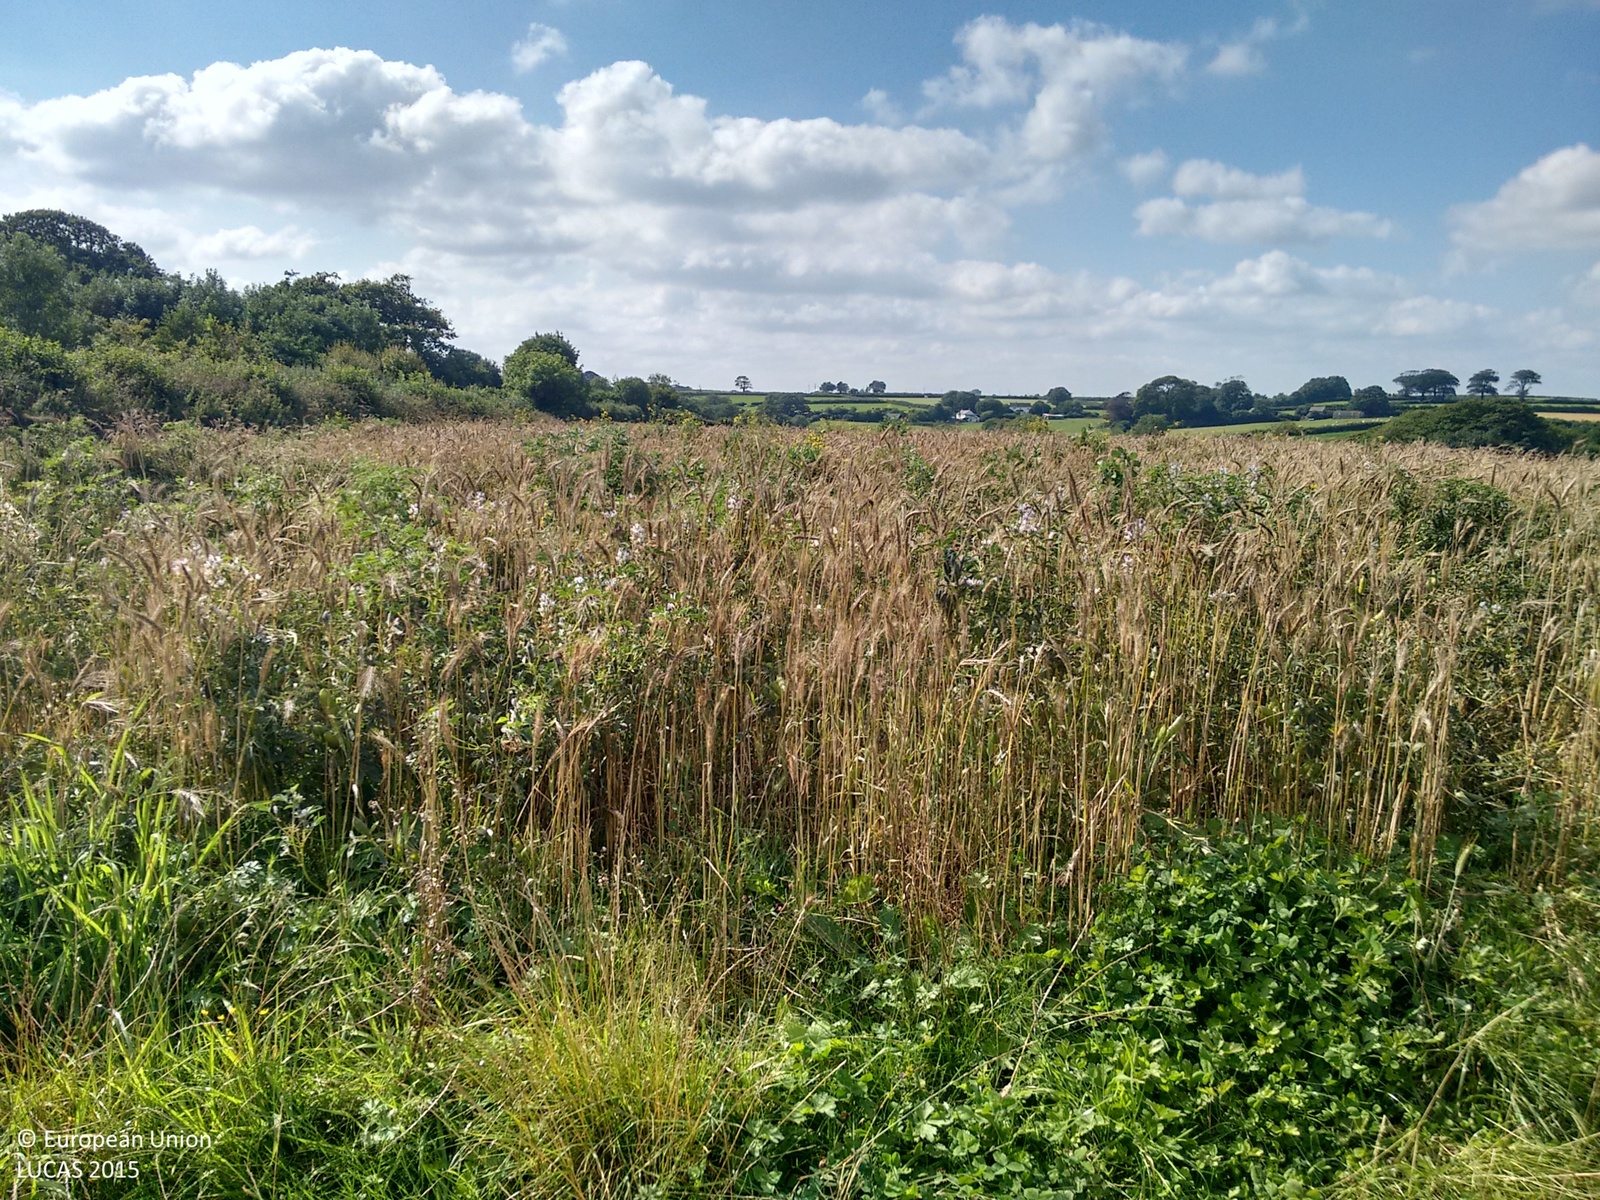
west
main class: Cropland
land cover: Barley
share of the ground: > 75 %
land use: Agriculture (excluding fallow land and kitchen gardens)
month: September
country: GB
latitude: 50.9193
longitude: -4.1662
